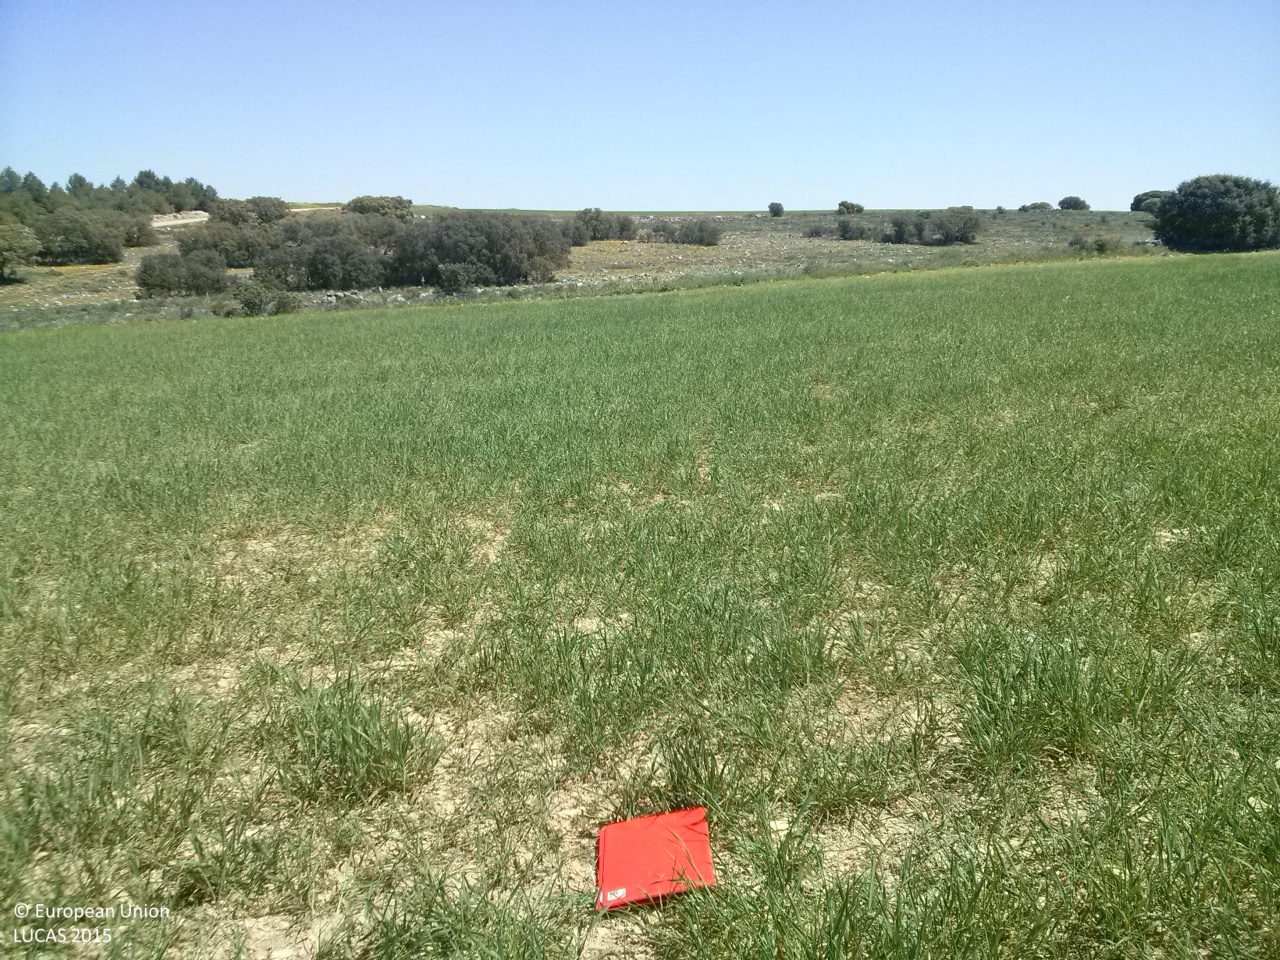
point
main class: Cropland
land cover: Barley
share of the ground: > 75 %
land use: Agriculture (excluding fallow land and kitchen gardens)
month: May
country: ES
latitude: 39.7785
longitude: -2.7563
